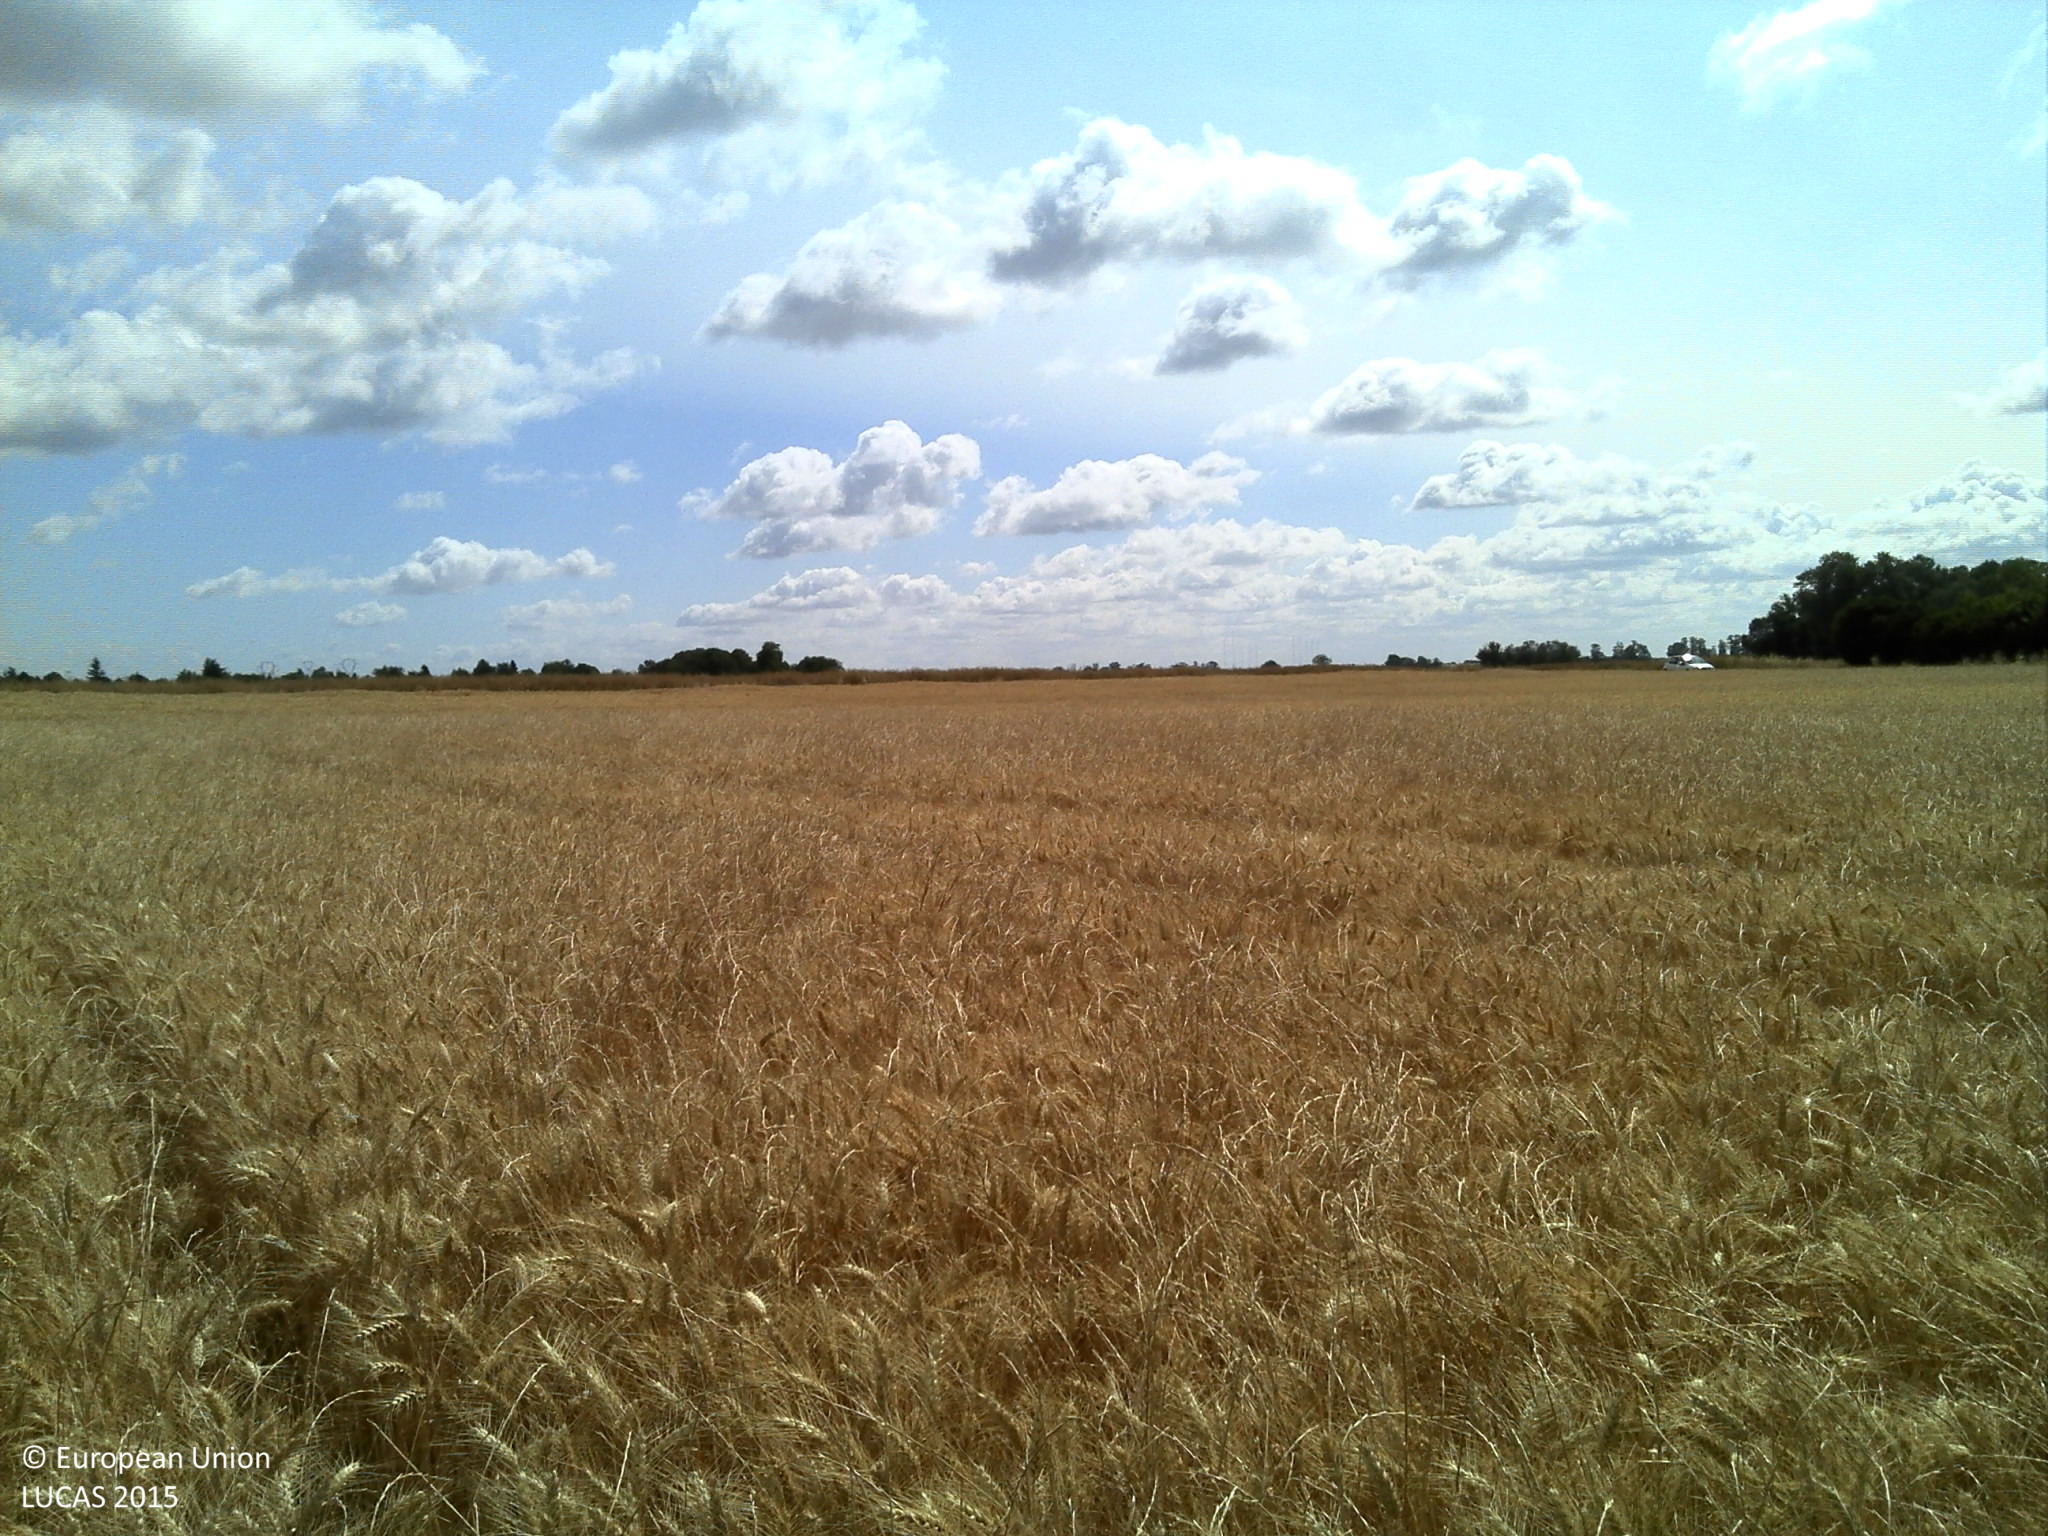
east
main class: Cropland
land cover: Durum wheat
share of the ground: > 75 %
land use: Agriculture (excluding fallow land and kitchen gardens)
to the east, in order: Durum wheat; Tracks; Rape and turnip rape; Tracks; Rape and turnip rape; Durum wheat
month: July
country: FR
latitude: 48.5405
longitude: 2.4175
